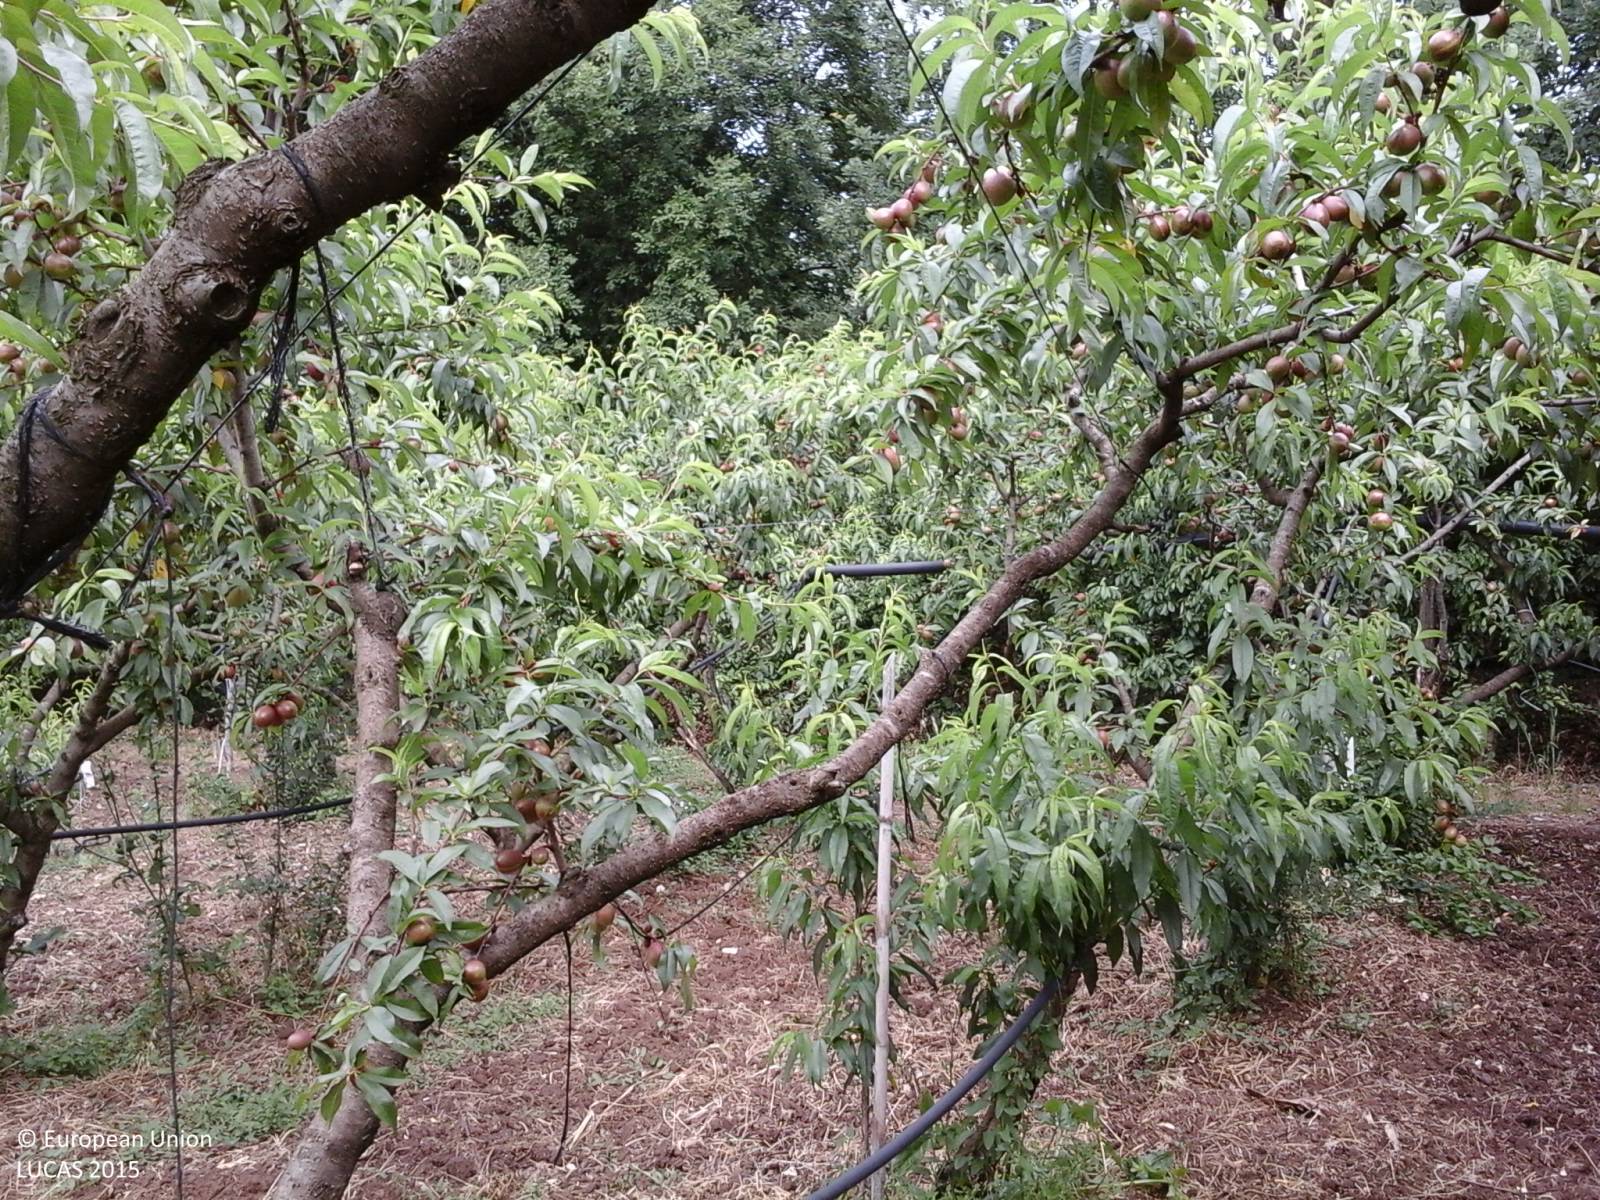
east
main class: Cropland
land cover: Other fruit trees and berries
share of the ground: > 75 %
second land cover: Spontaneously vegetated surfaces
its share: 10 - 25 %
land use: Agriculture (excluding fallow land and kitchen gardens)
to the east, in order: Other fruit trees and berries; Spontaneously vegetated surfaces; Tracks; Lines of trees; Abandoned hedges; Shrubland with sparse tree cover; Abandoned hedges; Other fruit trees and berries; Abandoned hedges; Tracks; Olive groves; Broadleaved woodland; Olive groves
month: May
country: IT
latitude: 41.1731
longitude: 14.2149
